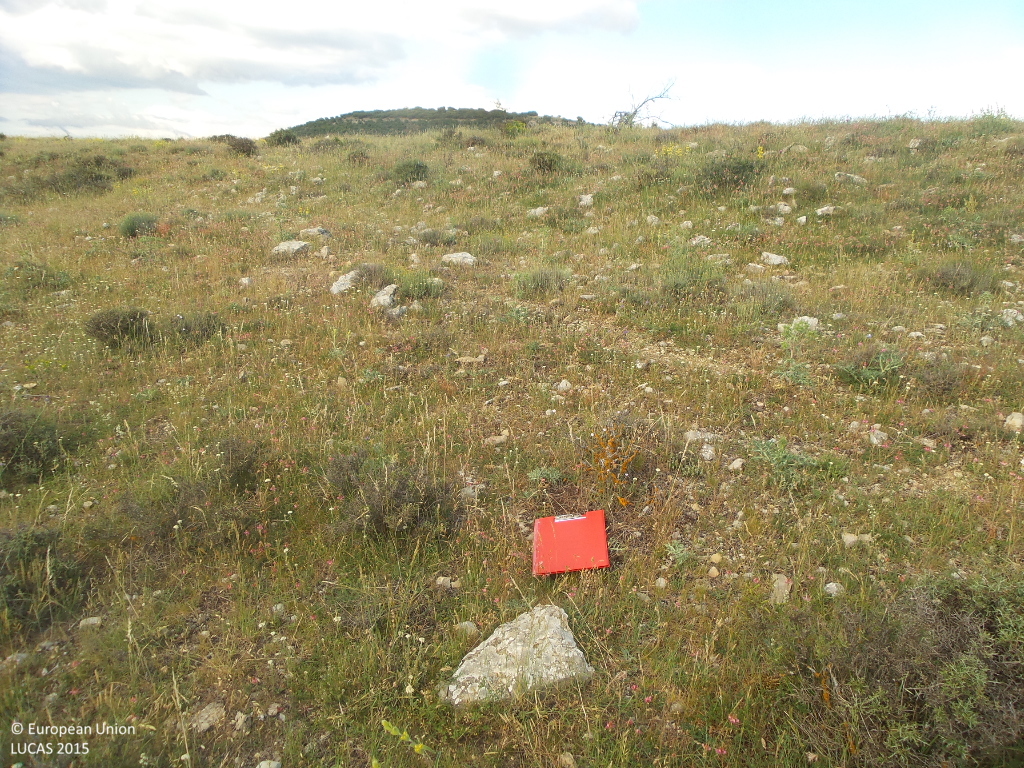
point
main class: Shrubland
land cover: Shrubland without tree cover
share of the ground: 25 - 50 %
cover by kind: shrubs 40 %, herbaceous plants 40 %, unconsolidated bare surface 20 %
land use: Semi-natural and natural areas not in use
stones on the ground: 10 - 25 %
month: June
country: ES
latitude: 41.3721
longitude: -3.0124
